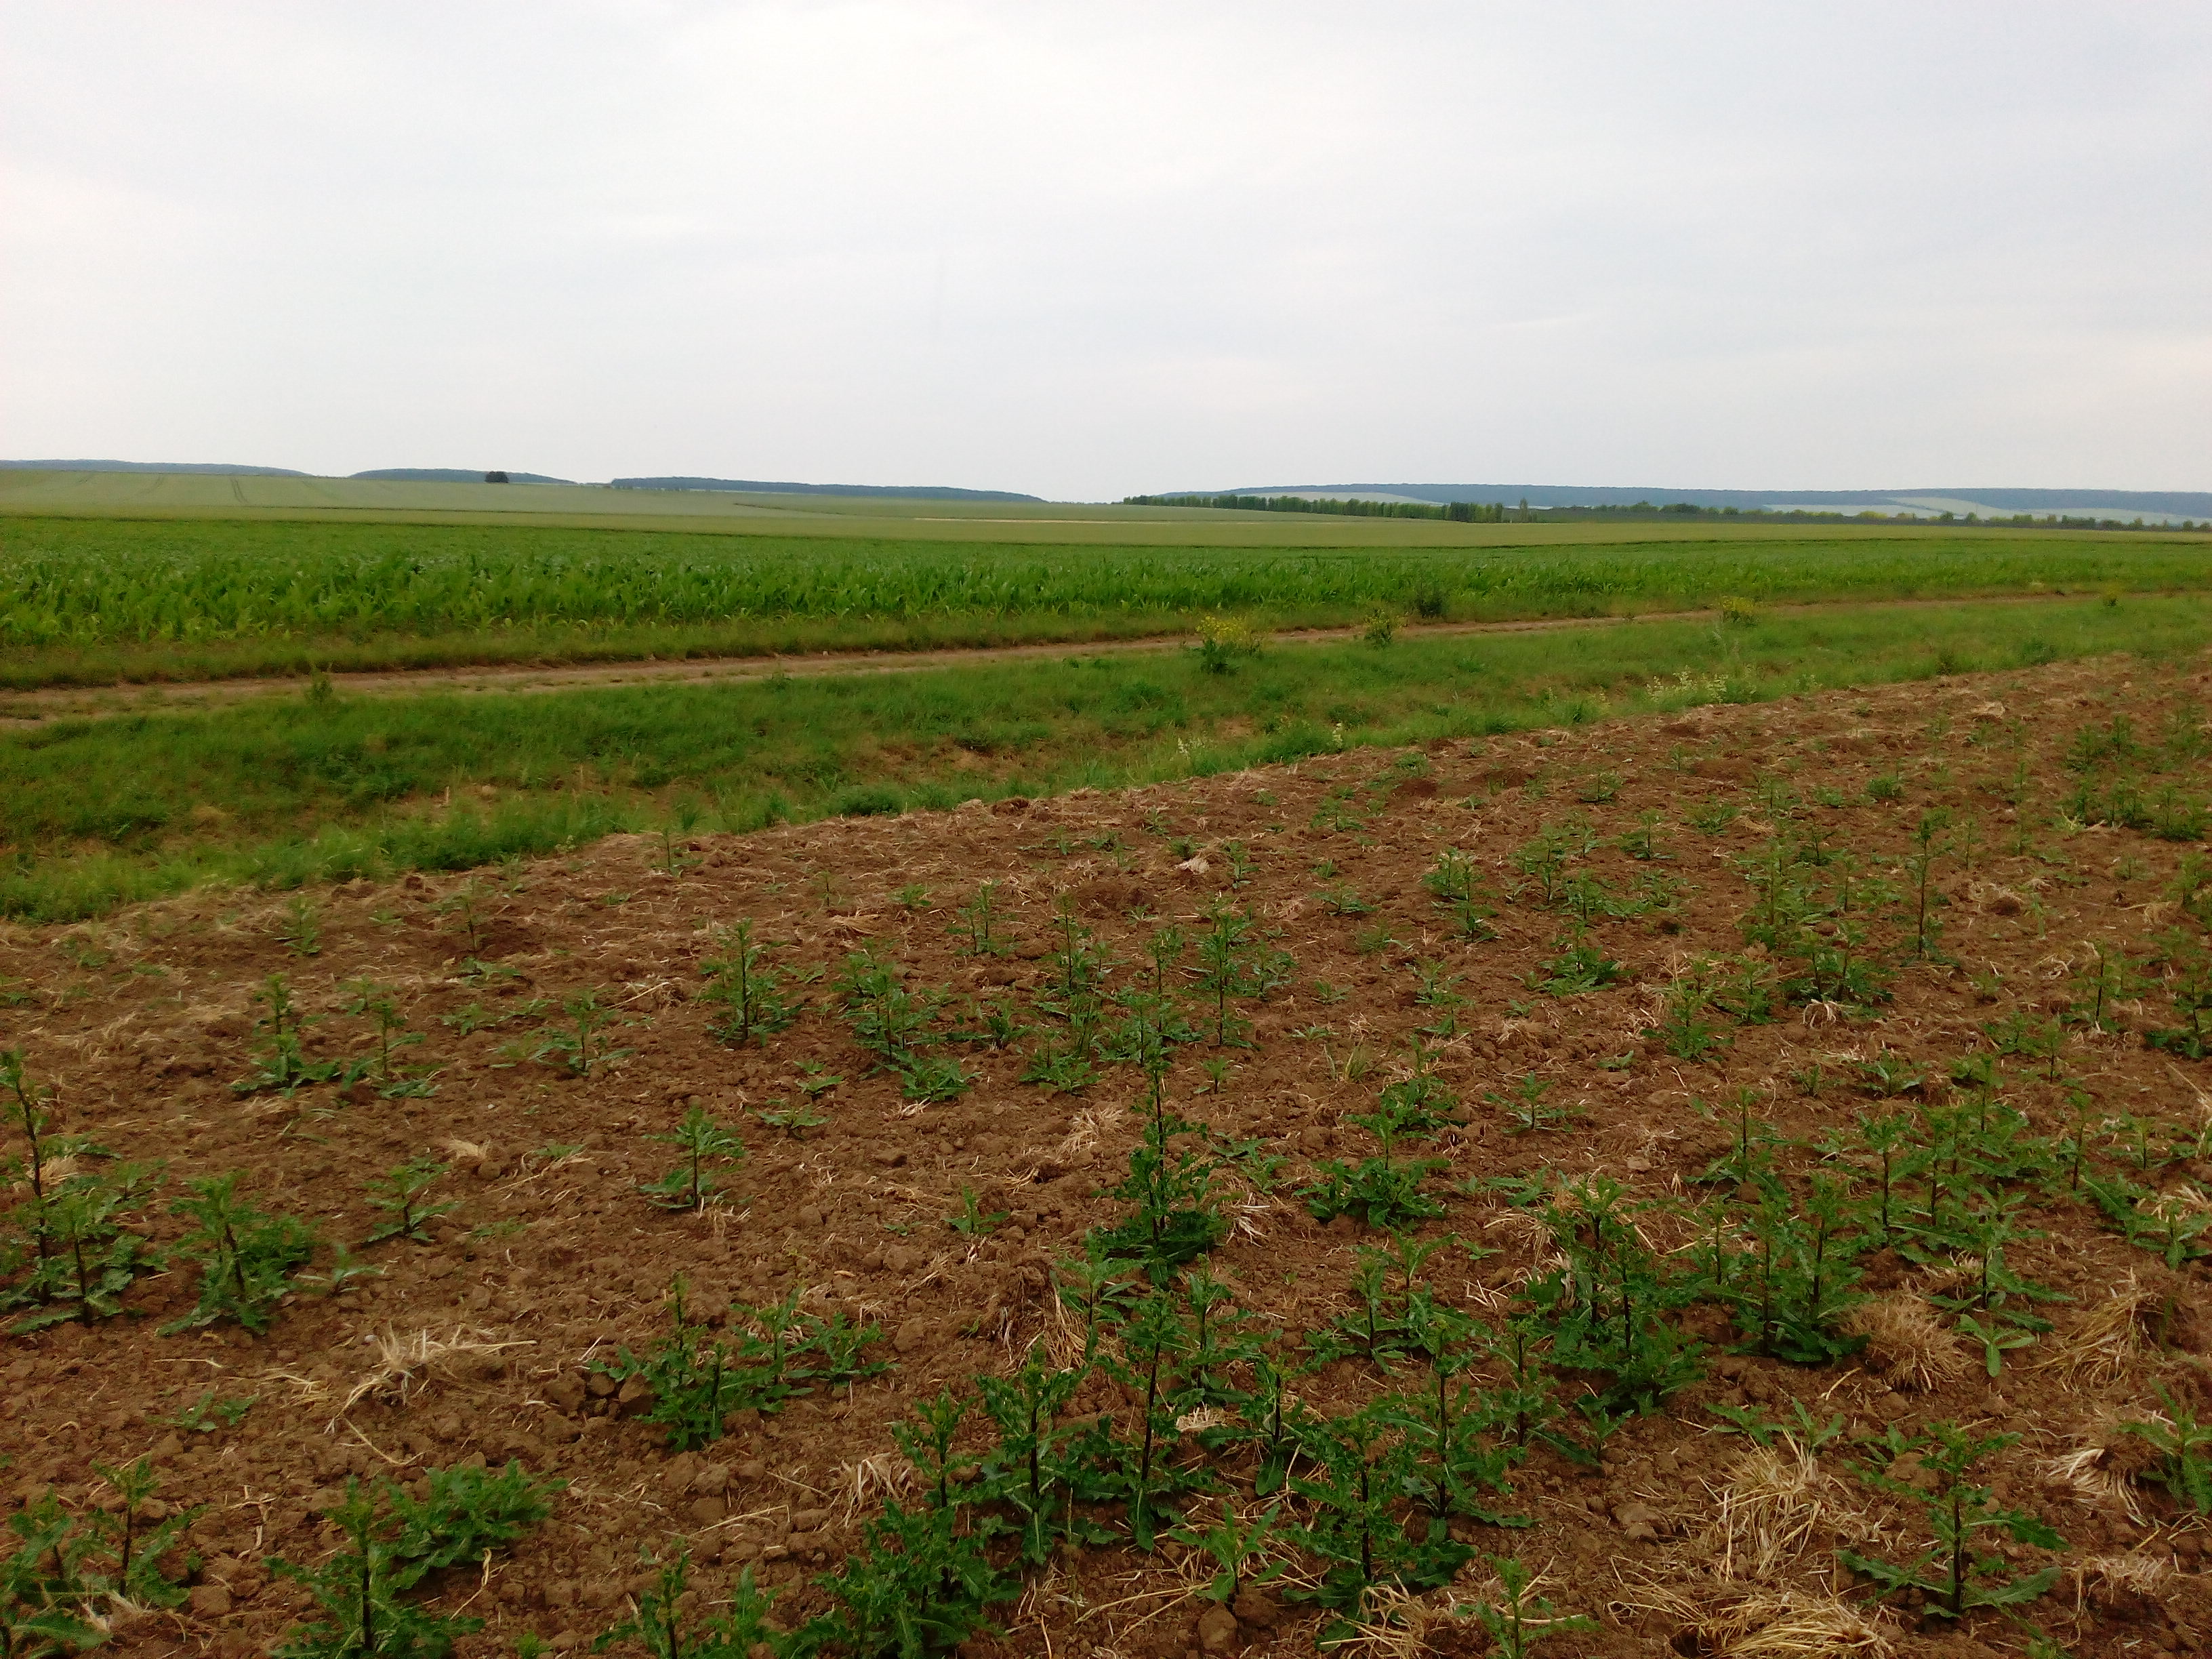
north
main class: Grassland
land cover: Grassland with sparse tree/shrub cover
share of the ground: > 75 %
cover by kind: herbaceous plants 95 %, broadleaved forest trees 5 %
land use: Agriculture (excluding fallow land and kitchen gardens)
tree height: > 5 m
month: June
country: DE
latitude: 51.2585
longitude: 11.0171
